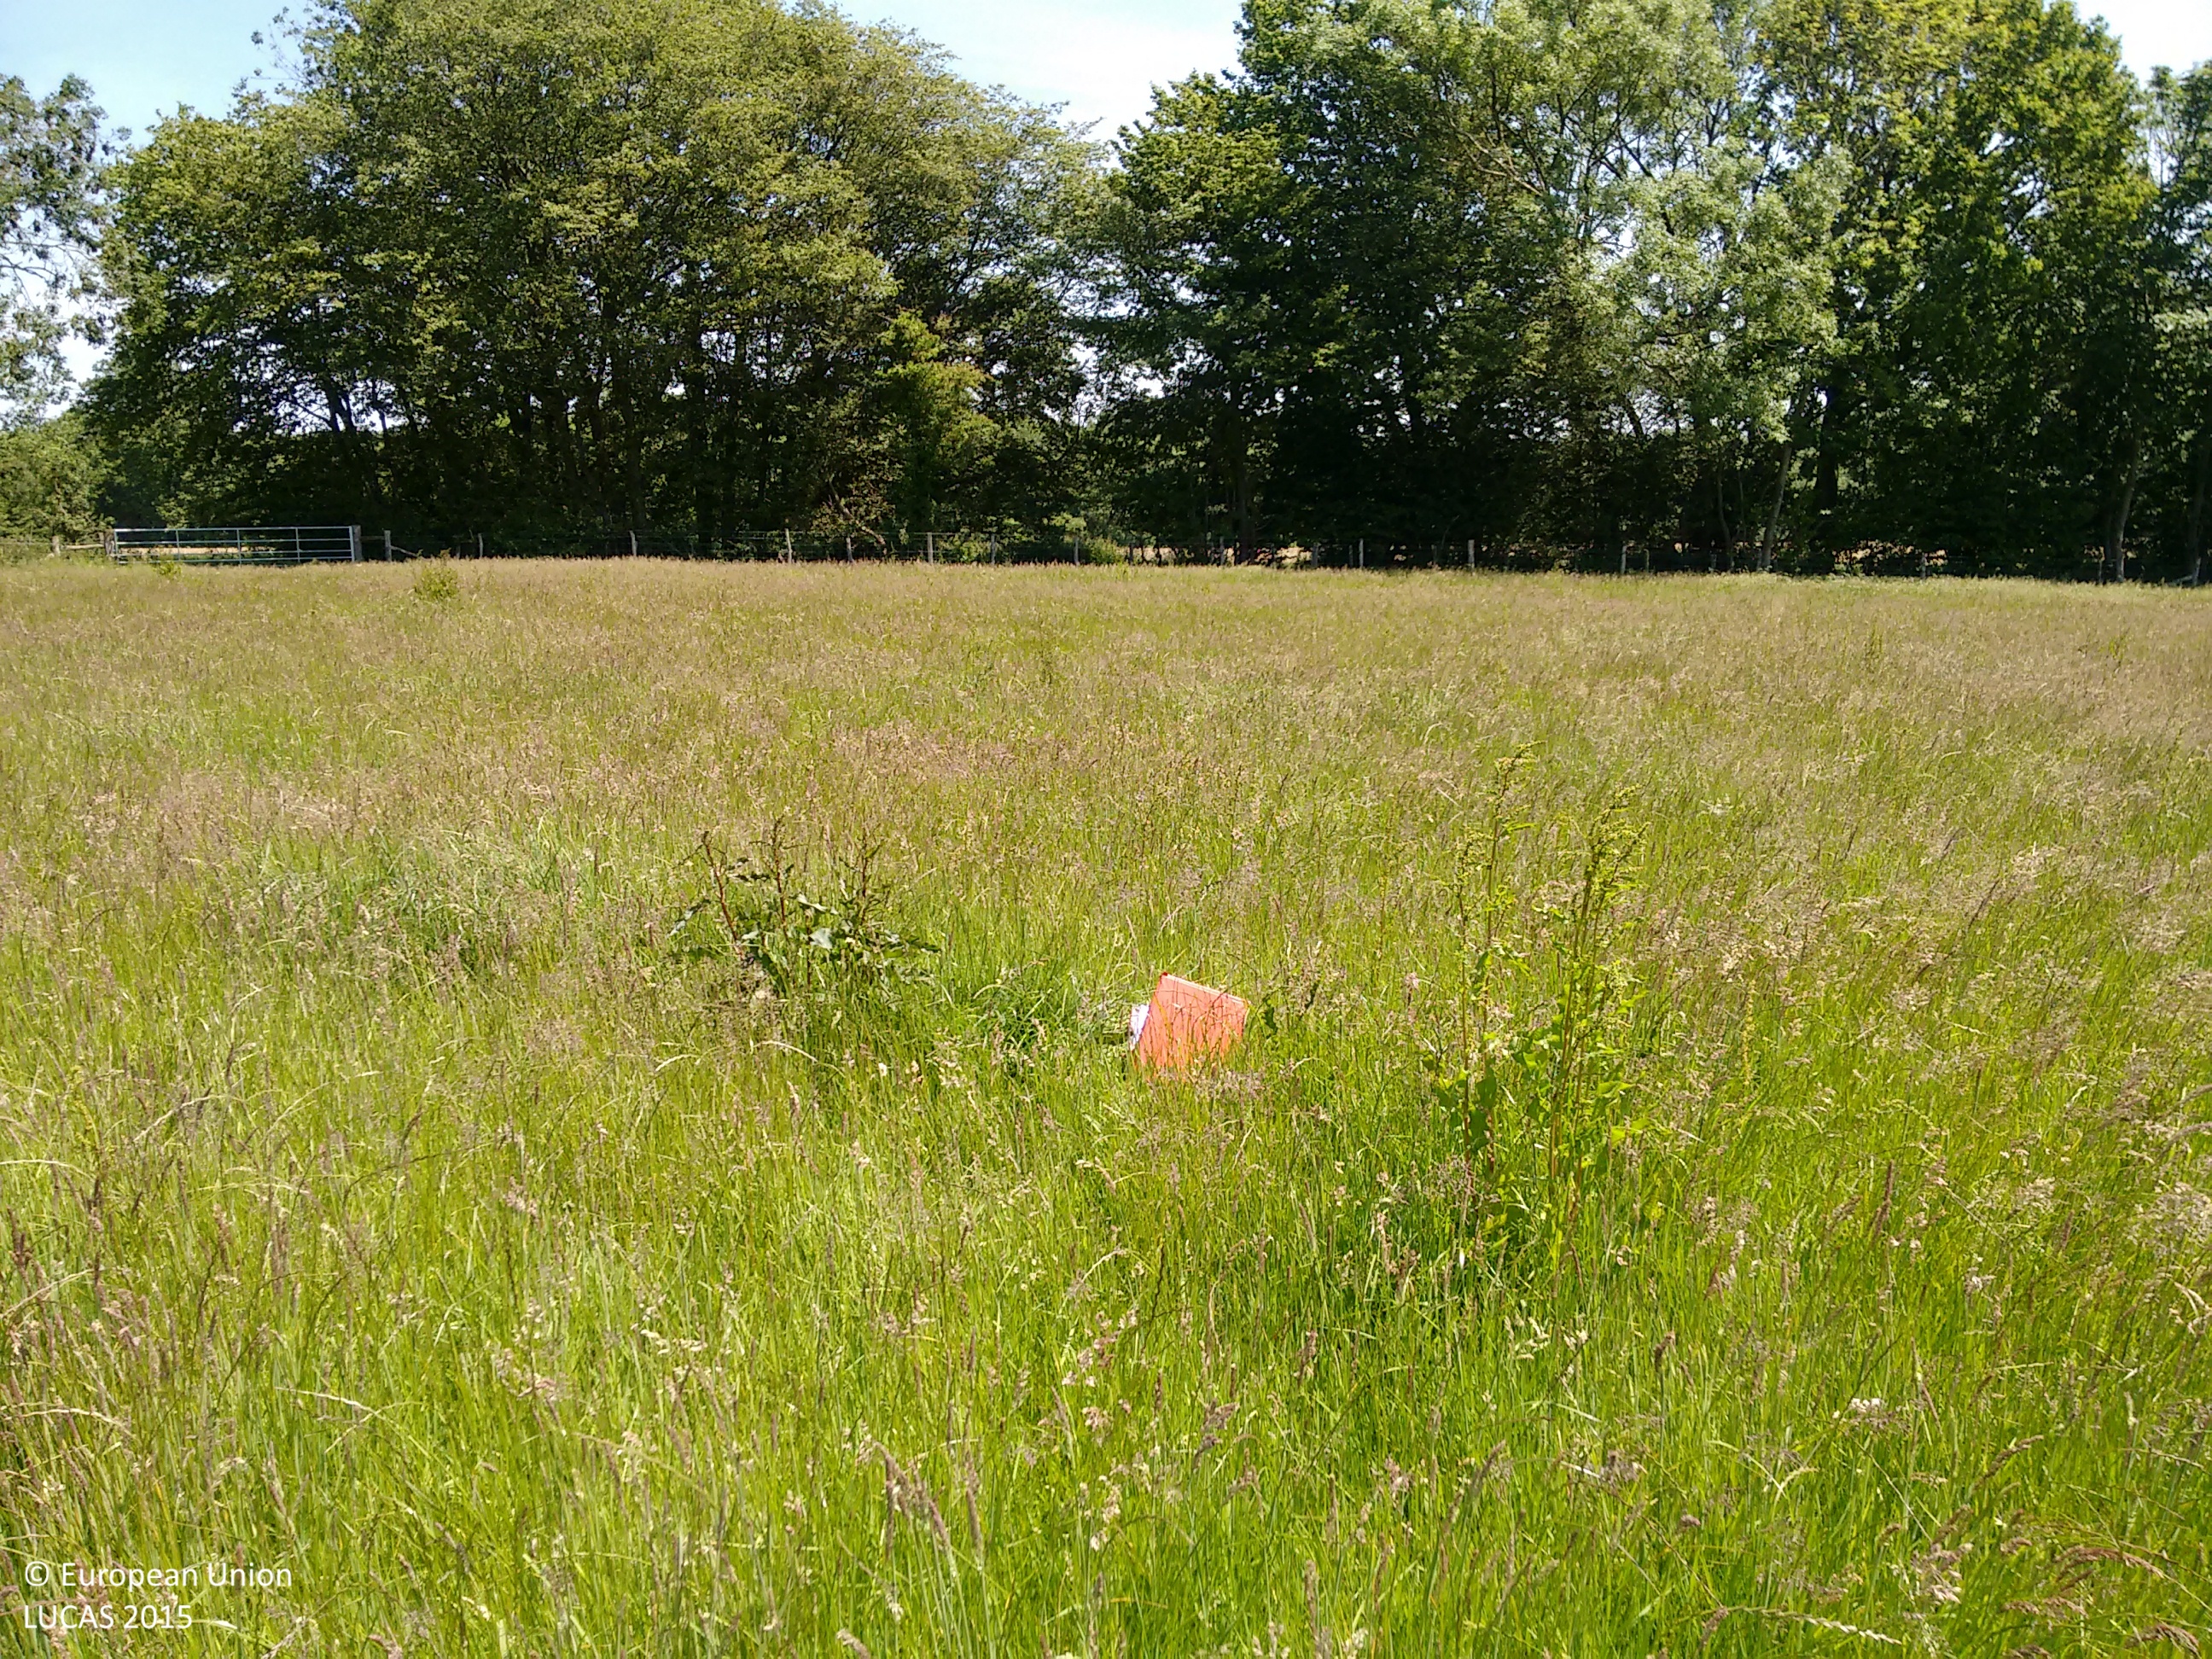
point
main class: Grassland
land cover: Grassland without tree/shrub cover
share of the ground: > 75 %
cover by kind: herbaceous plants 100 %
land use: Agriculture (excluding fallow land and kitchen gardens)
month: June
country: GB
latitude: 51.0460
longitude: 0.4002
